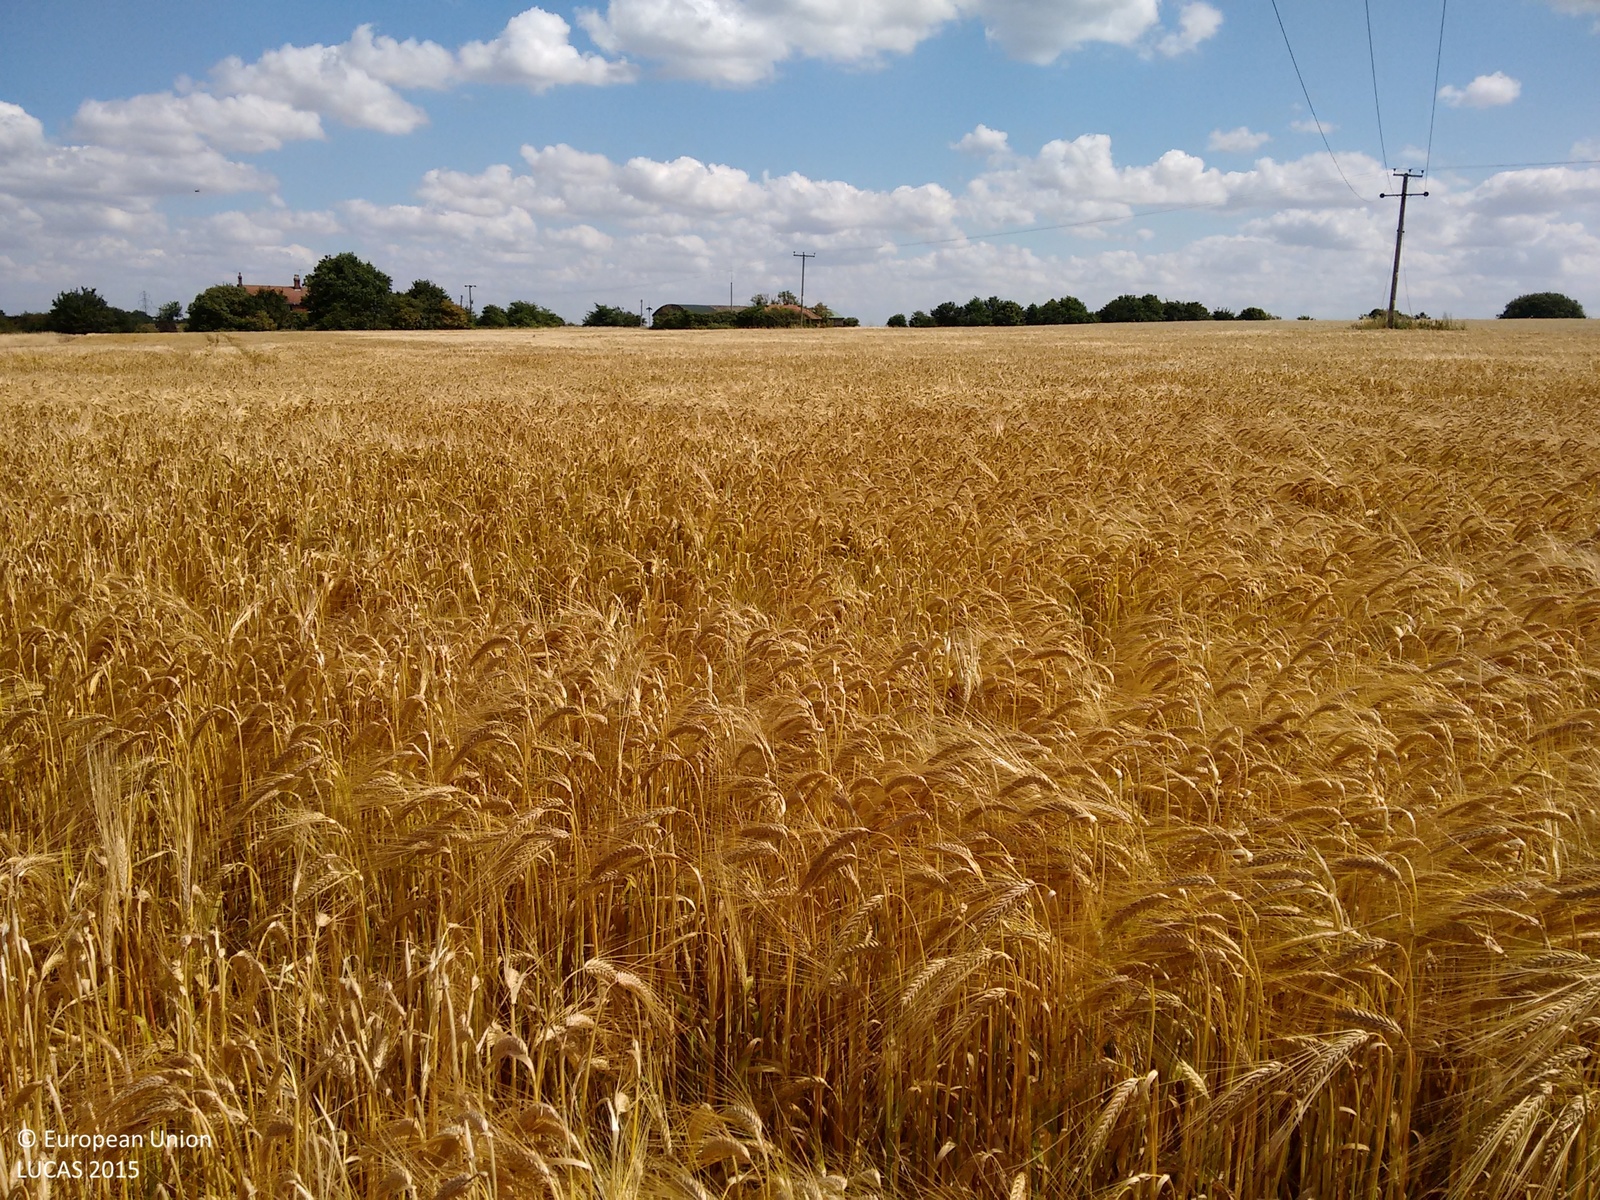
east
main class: Cropland
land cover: Barley
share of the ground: > 75 %
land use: Agriculture (excluding fallow land and kitchen gardens)
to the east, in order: Barley; Electric lines; Barley; Electric lines; Barley; Tracks; Grassland with sparse tree/shrub cover; Ditches and canals; Grass margins; Paved roads, cycling and walking lanes
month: July
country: GB
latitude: 52.7316
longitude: 0.4201
